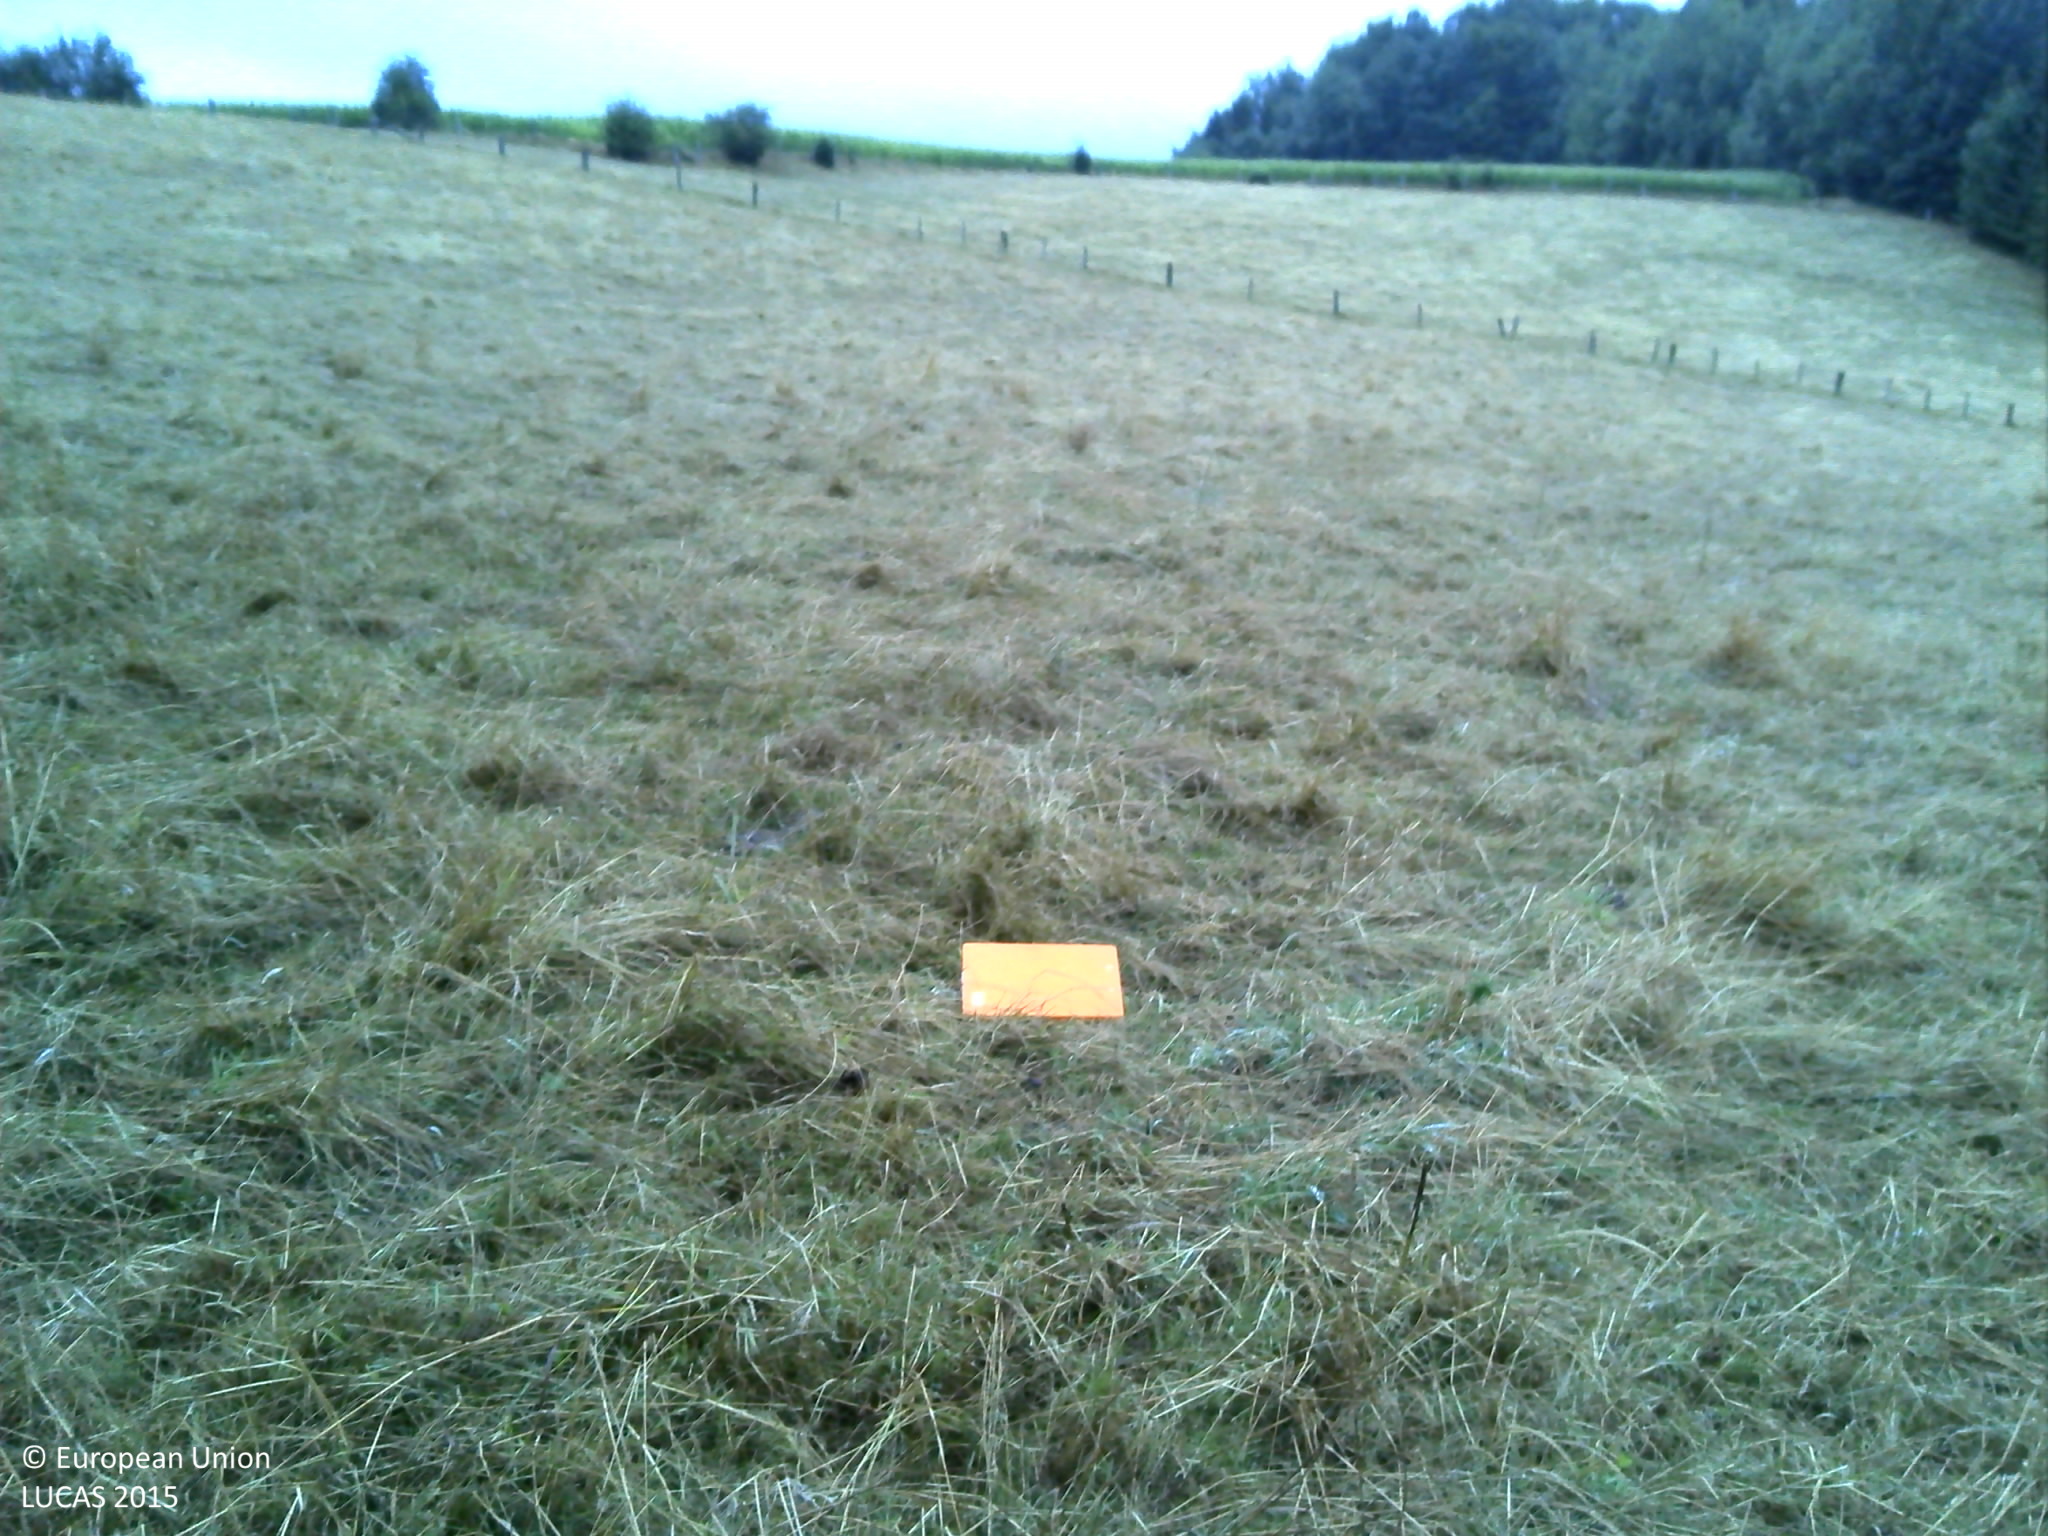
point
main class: Grassland
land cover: Grassland with sparse tree/shrub cover
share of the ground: > 75 %
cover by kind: herbaceous plants 95 %, broadleaved forest trees 5 %
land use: Agriculture (excluding fallow land and kitchen gardens)
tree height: > 5 m
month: July
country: FR
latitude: 47.9990
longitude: 6.2884
